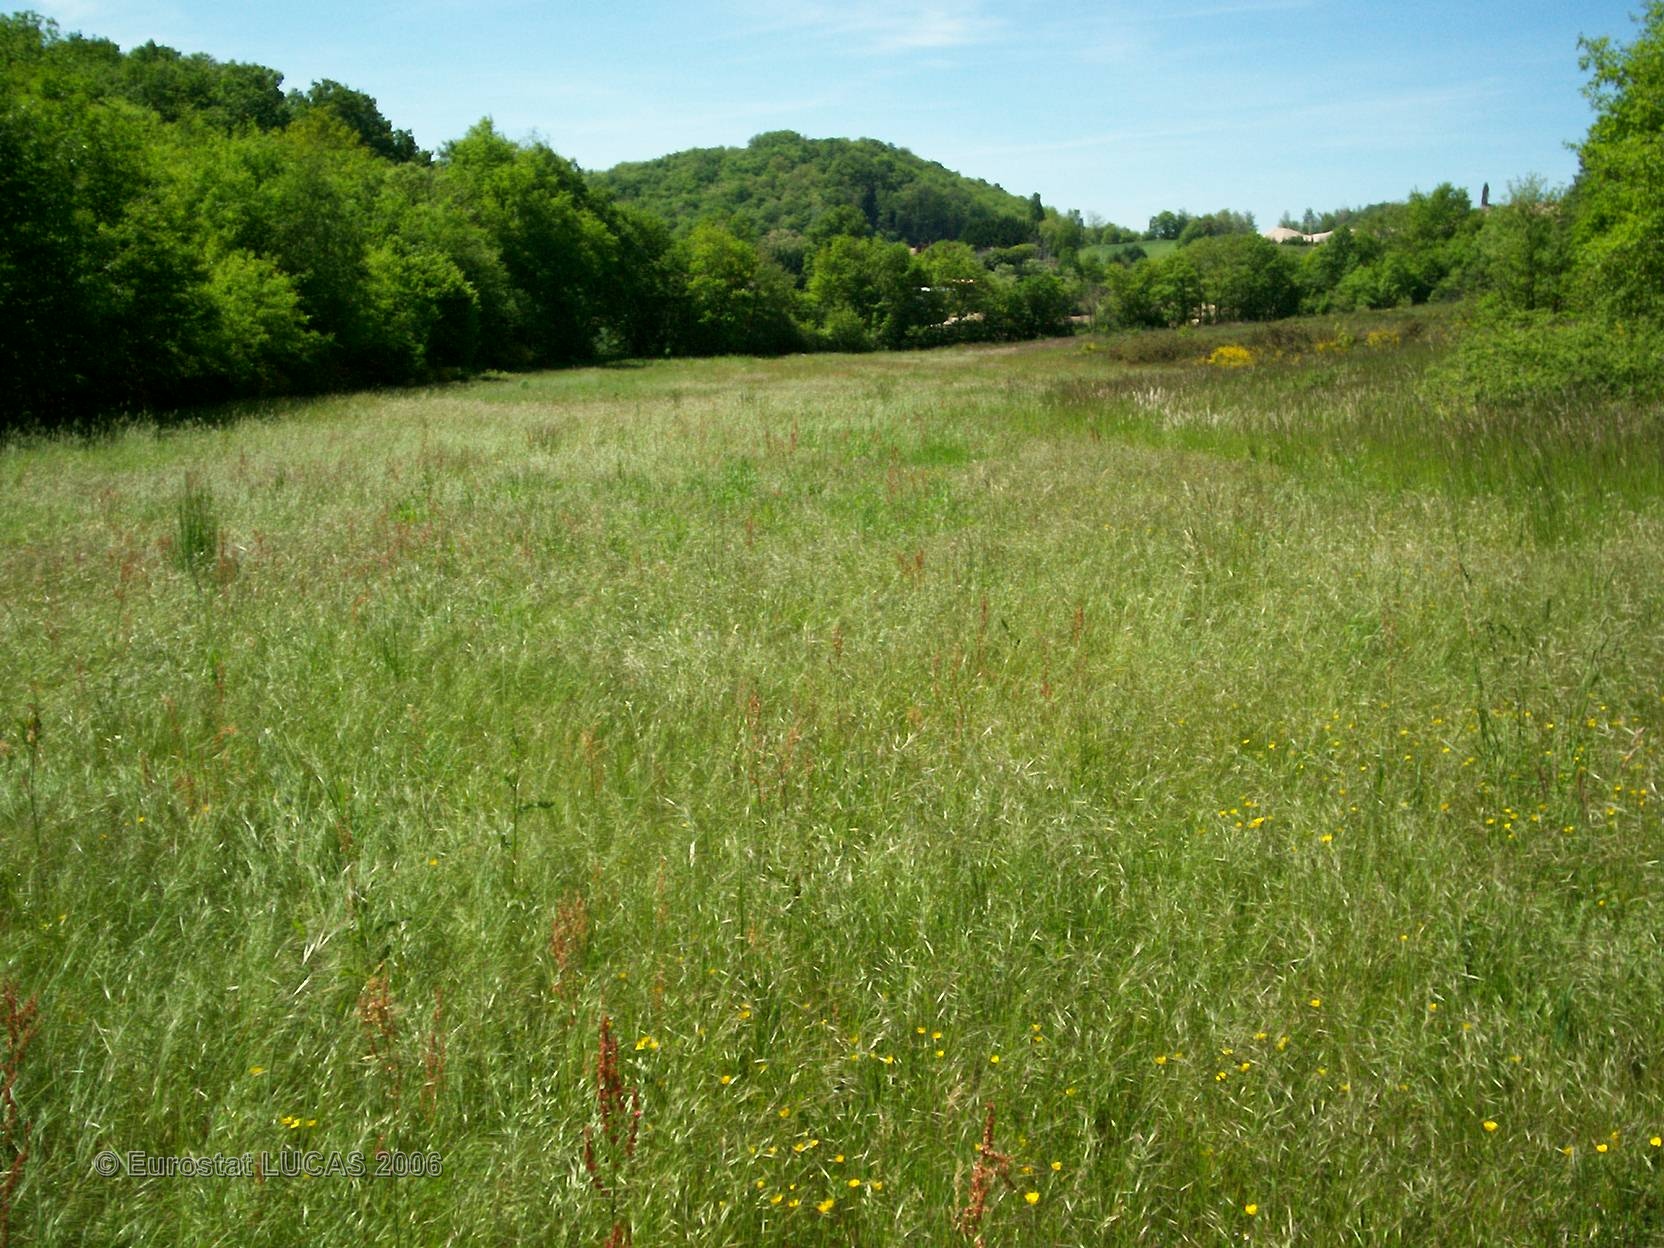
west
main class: Grassland
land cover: Grassland without tree/shrub cover
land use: Agriculture (excluding fallow land and kitchen gardens)
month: May
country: FR
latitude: 43.2066
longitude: 0.9066
